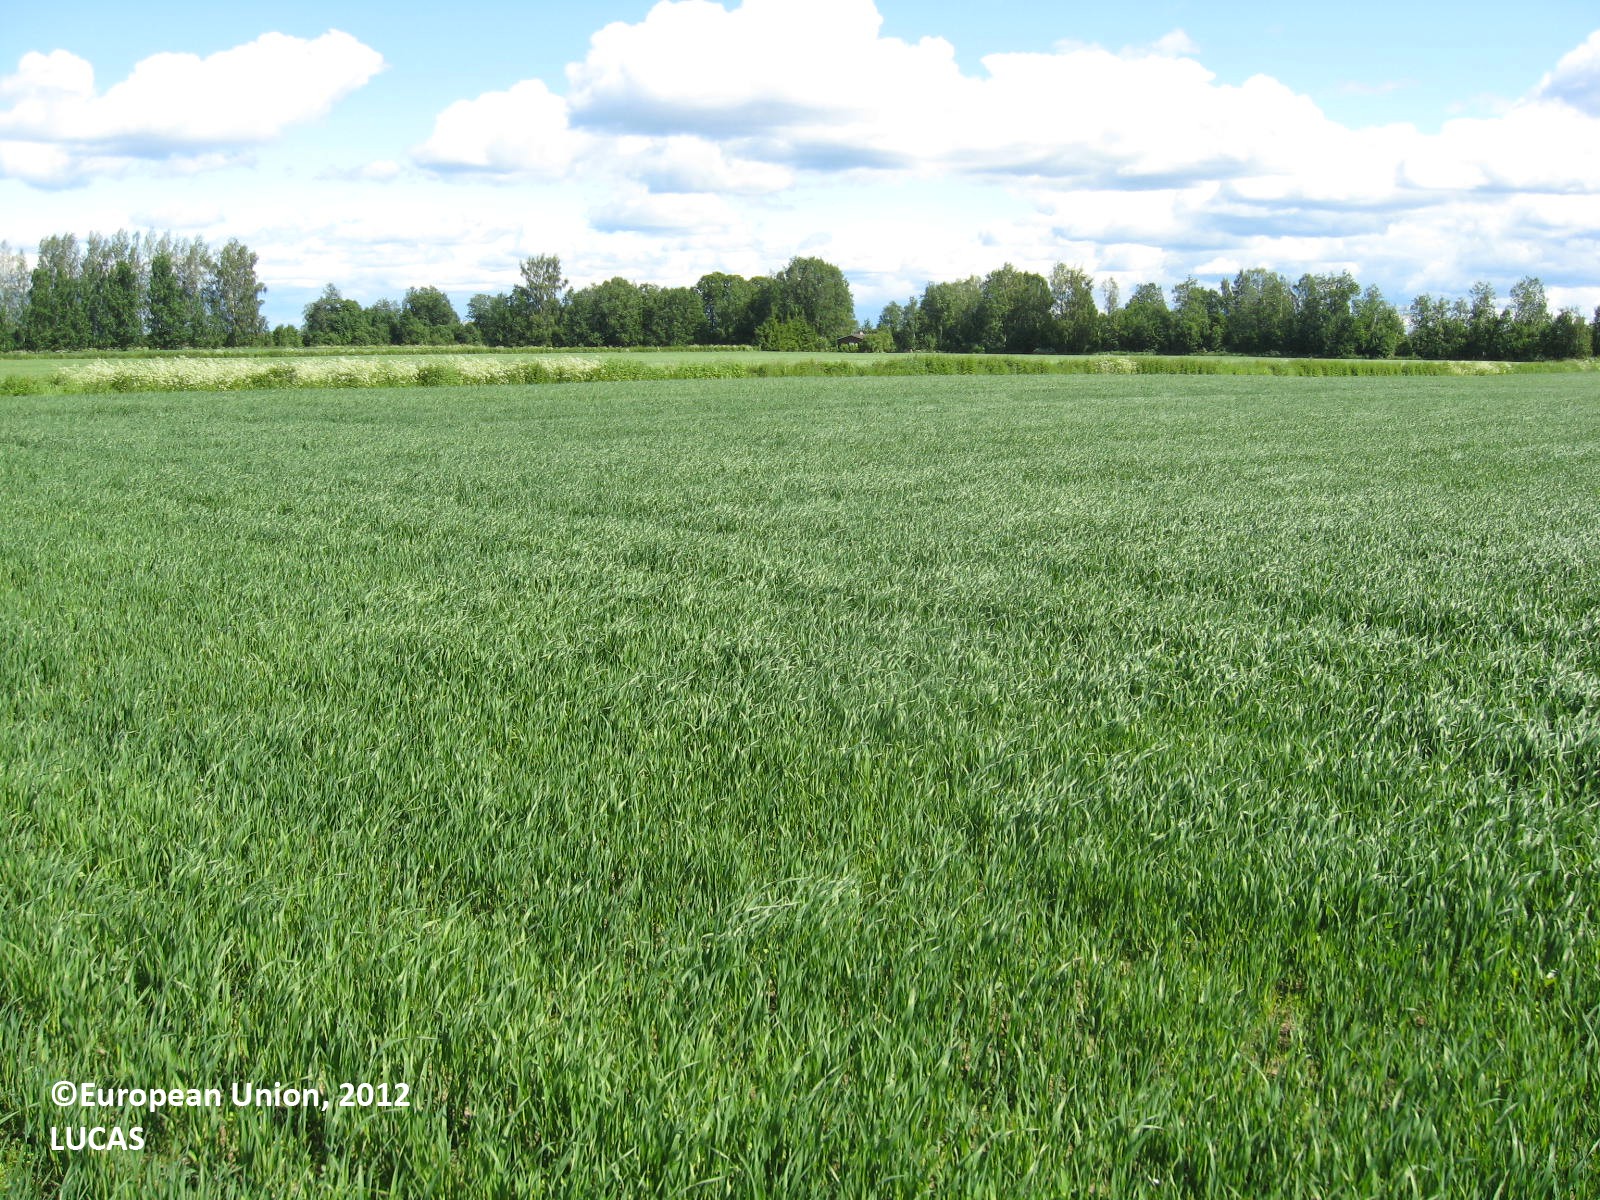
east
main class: Cropland
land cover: Oats
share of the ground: 50 - 75 %
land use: Agriculture (excluding fallow land and kitchen gardens)
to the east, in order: Oats; Shruby margins; Ditches and canals; Shruby margins; Barley; Grassland without tree/shrub cover; Shruby margins; Common wheat
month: June
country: FI
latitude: 62.7750
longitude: 22.6142
